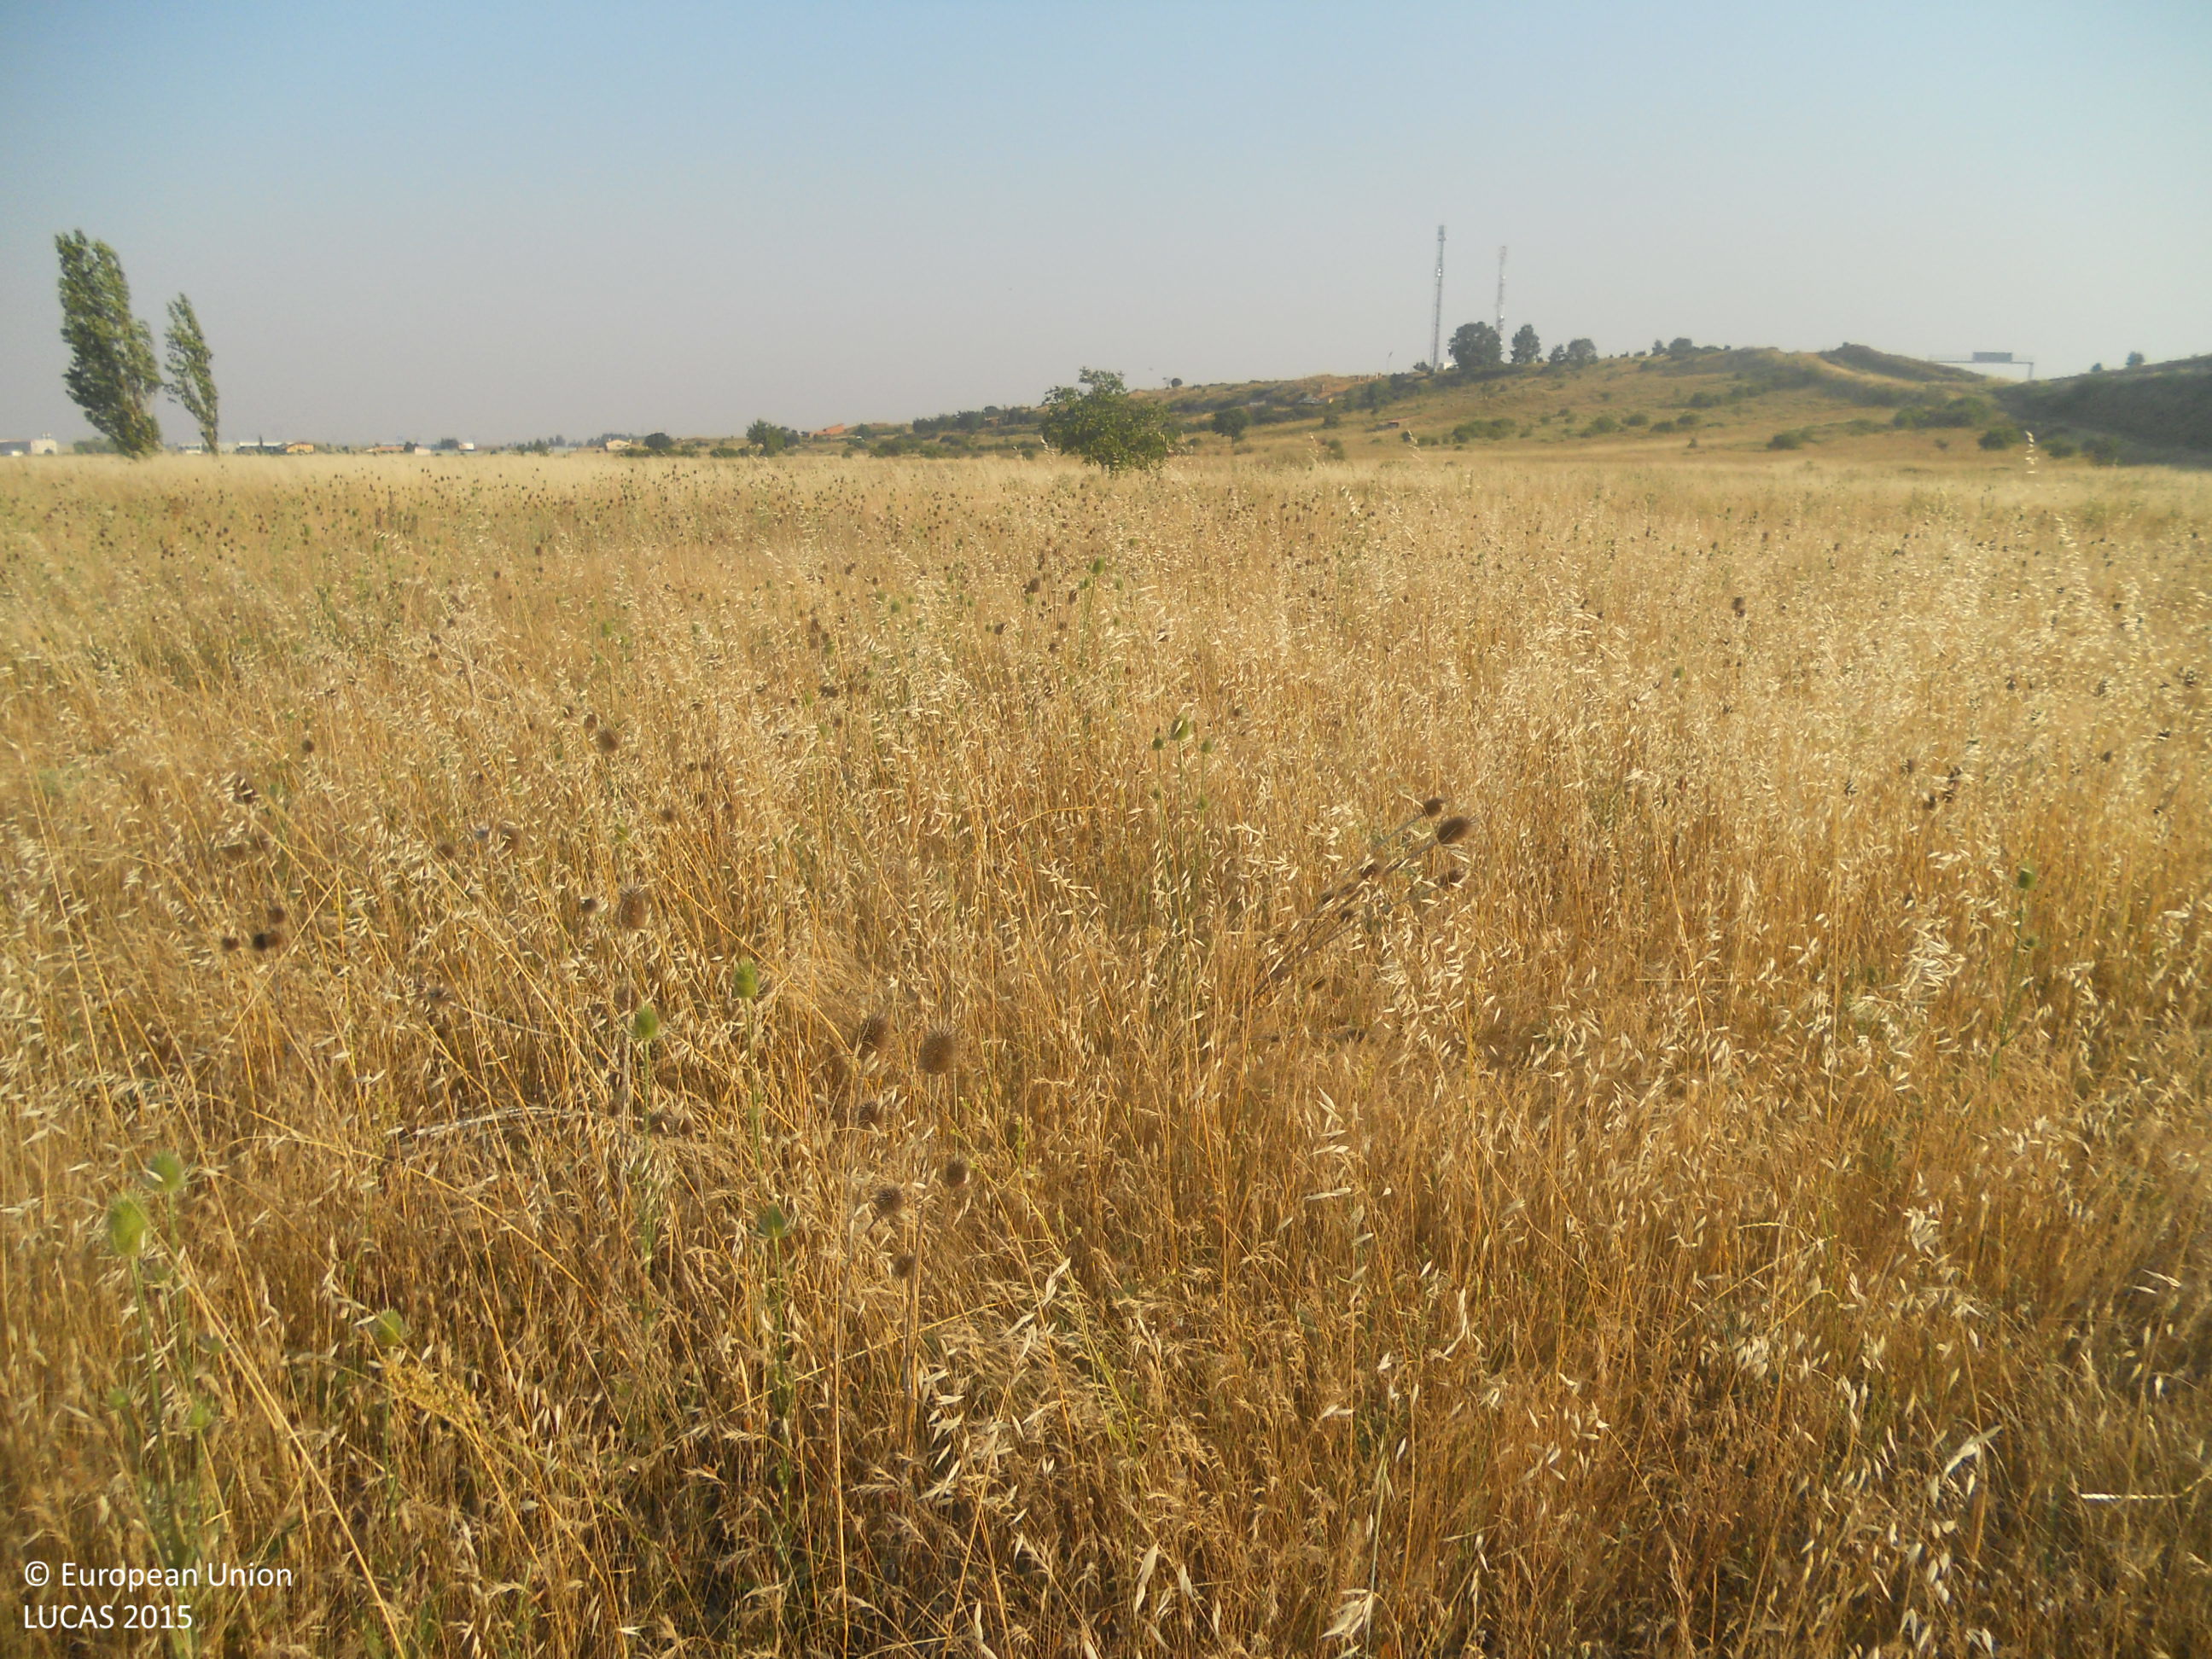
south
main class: Grassland
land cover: Grassland without tree/shrub cover
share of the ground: > 75 %
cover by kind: herbaceous plants 100 %
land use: Agriculture (excluding fallow land and kitchen gardens)
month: July
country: ES
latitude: 42.5209
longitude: -5.5923
